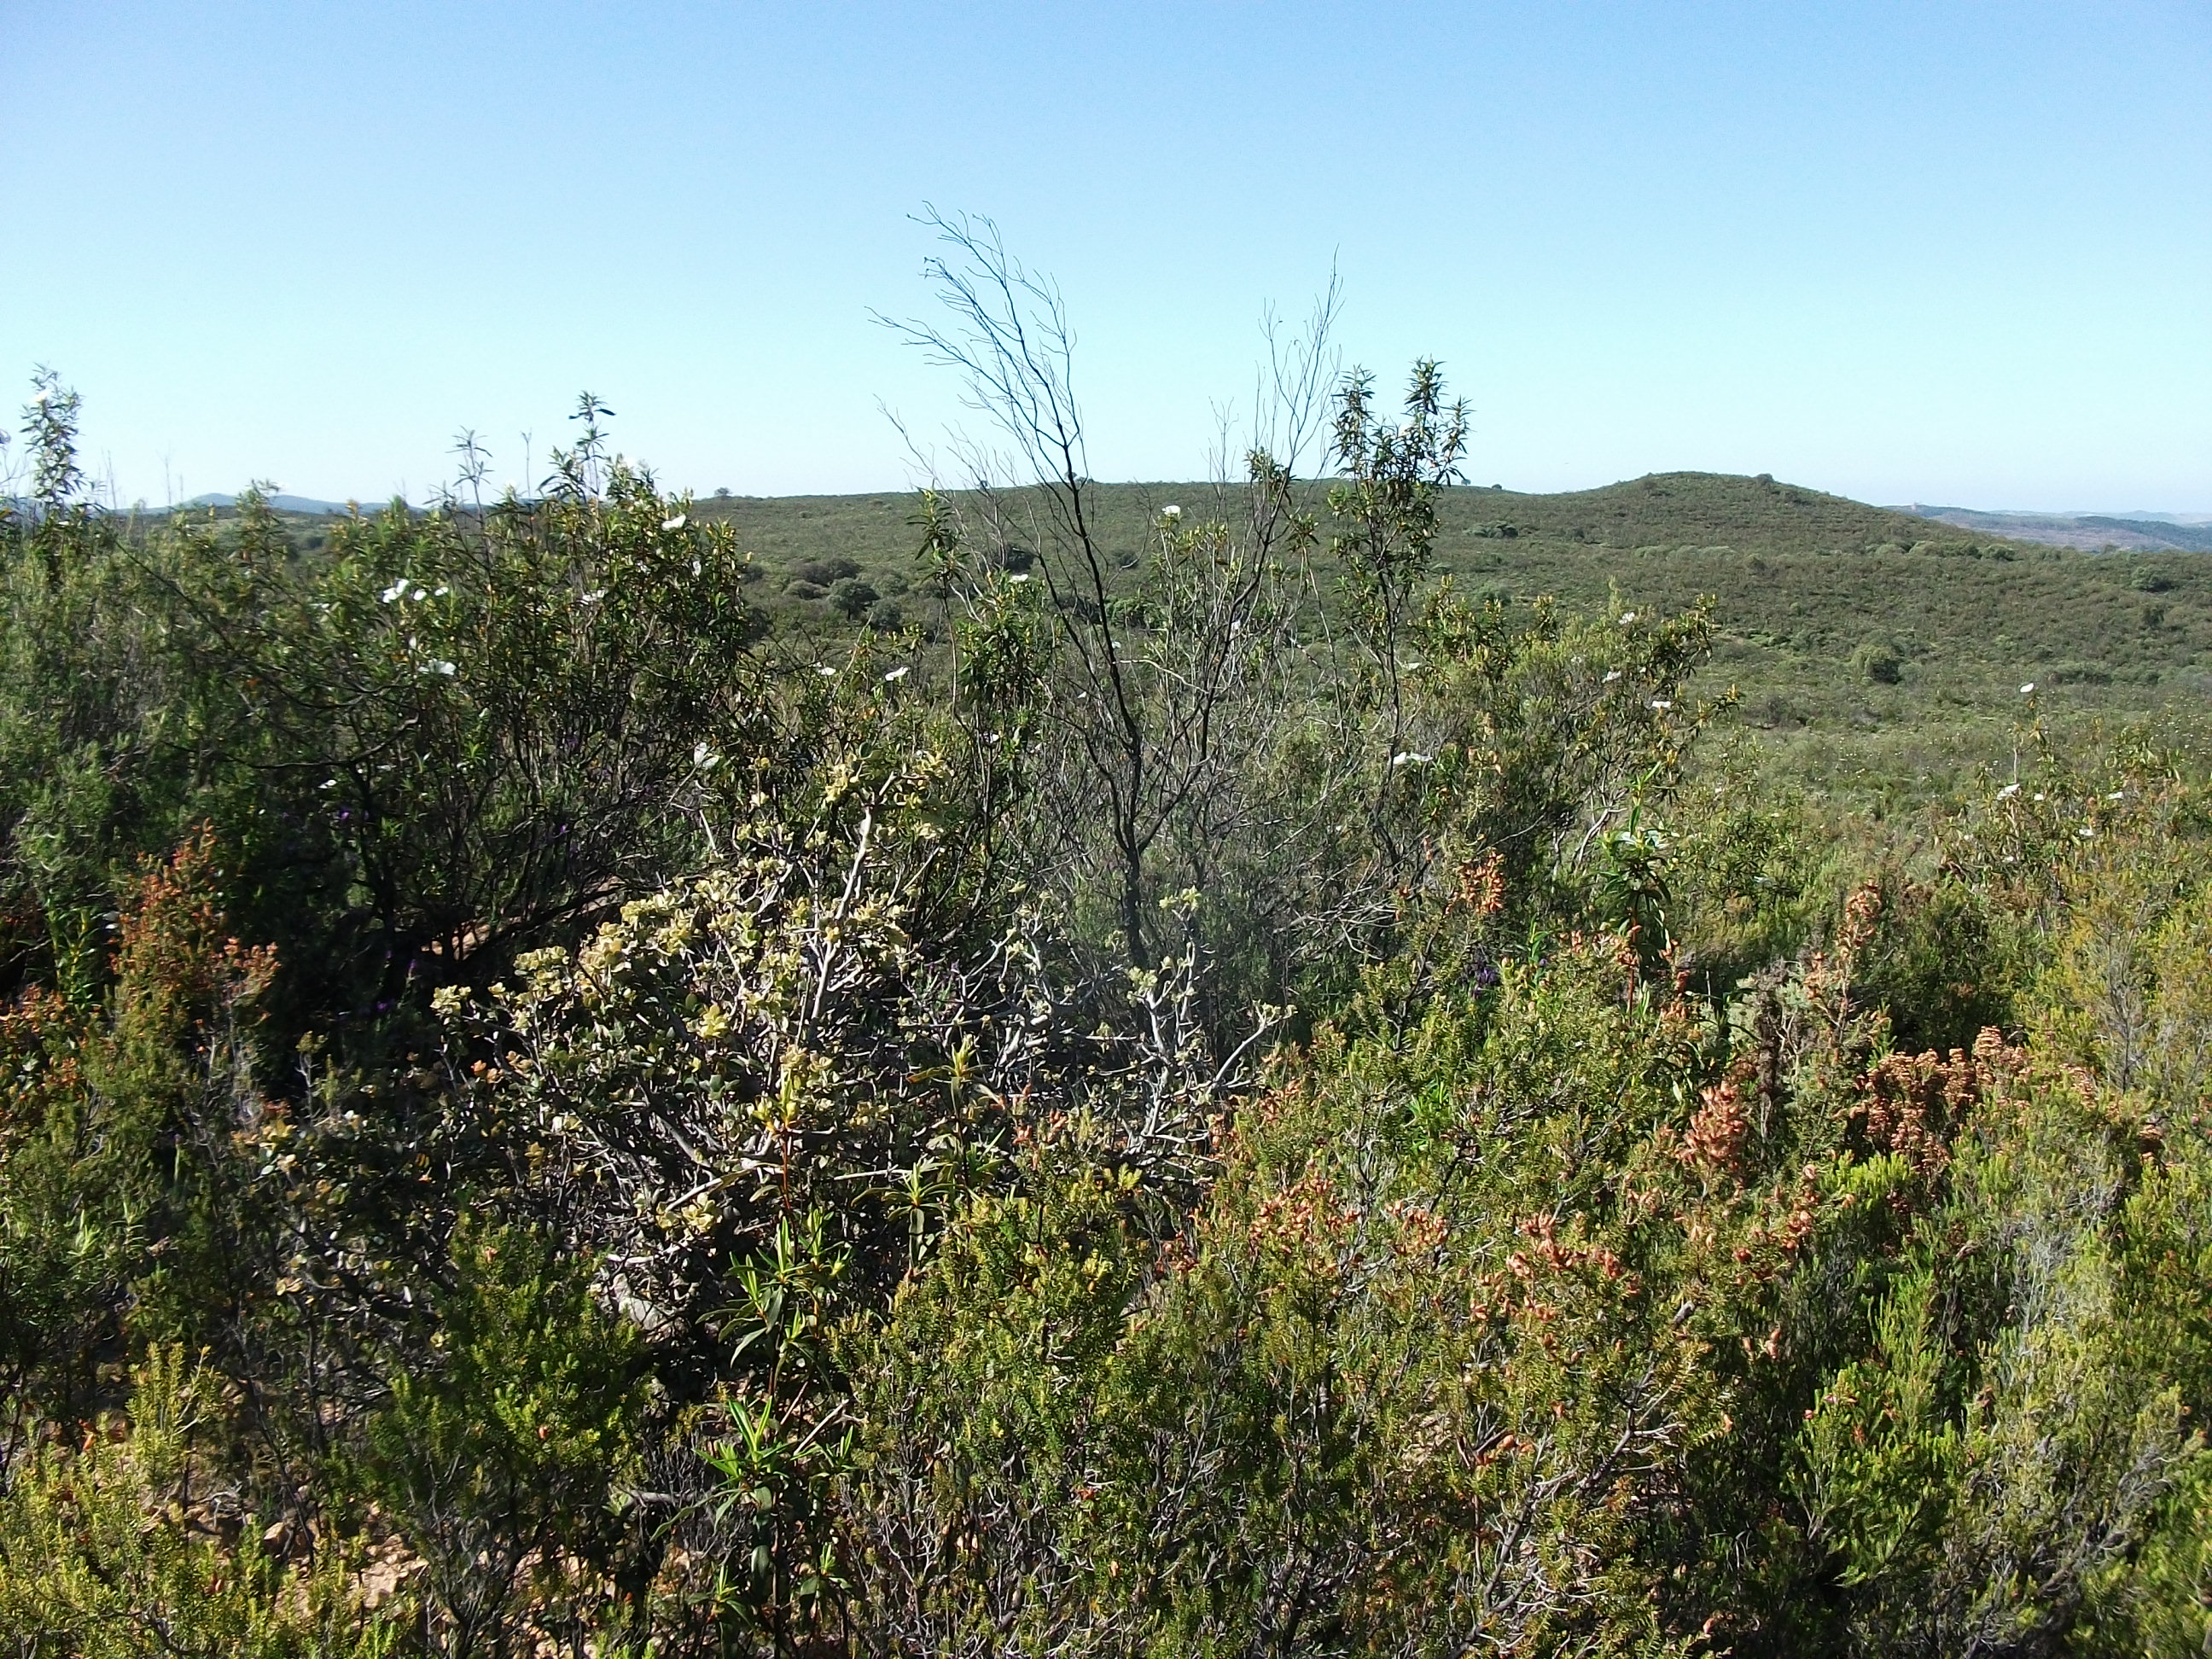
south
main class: Shrubland
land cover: Shrubland without tree cover
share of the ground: > 75 %
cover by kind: shrubs 95 %, unconsolidated bare surface 5 %
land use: Semi-natural and natural areas not in use
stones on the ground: 10 - 25 %
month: April
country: ES
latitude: 37.8501
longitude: -6.5787
